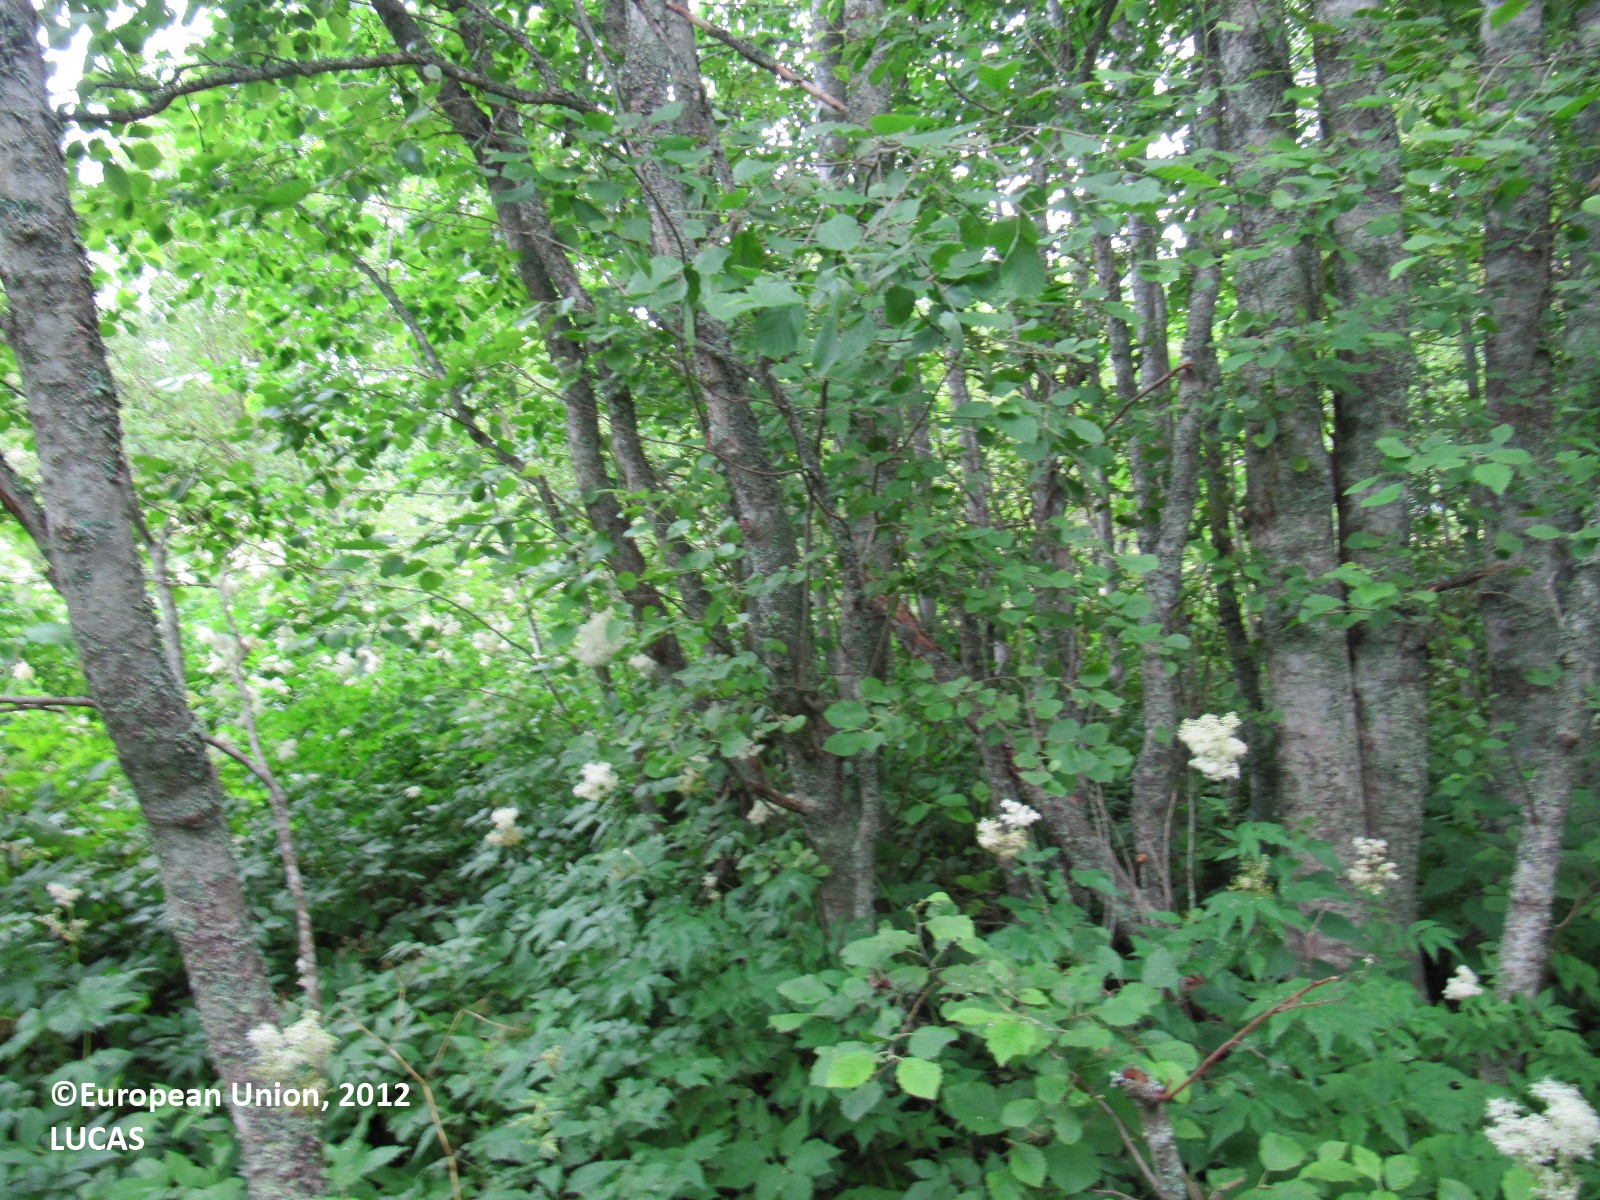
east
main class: Woodland
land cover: Broadleaved woodland
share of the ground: > 75 %
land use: Forestry
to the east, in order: Broadleaved woodland; Grassland with sparse tree/shrub cover; Ditches and canals; Oats; Paved roads, cycling and walking lanes; Oats; Artificial constructions in urban areas
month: July
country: FI
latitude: 60.3821
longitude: 23.9363
